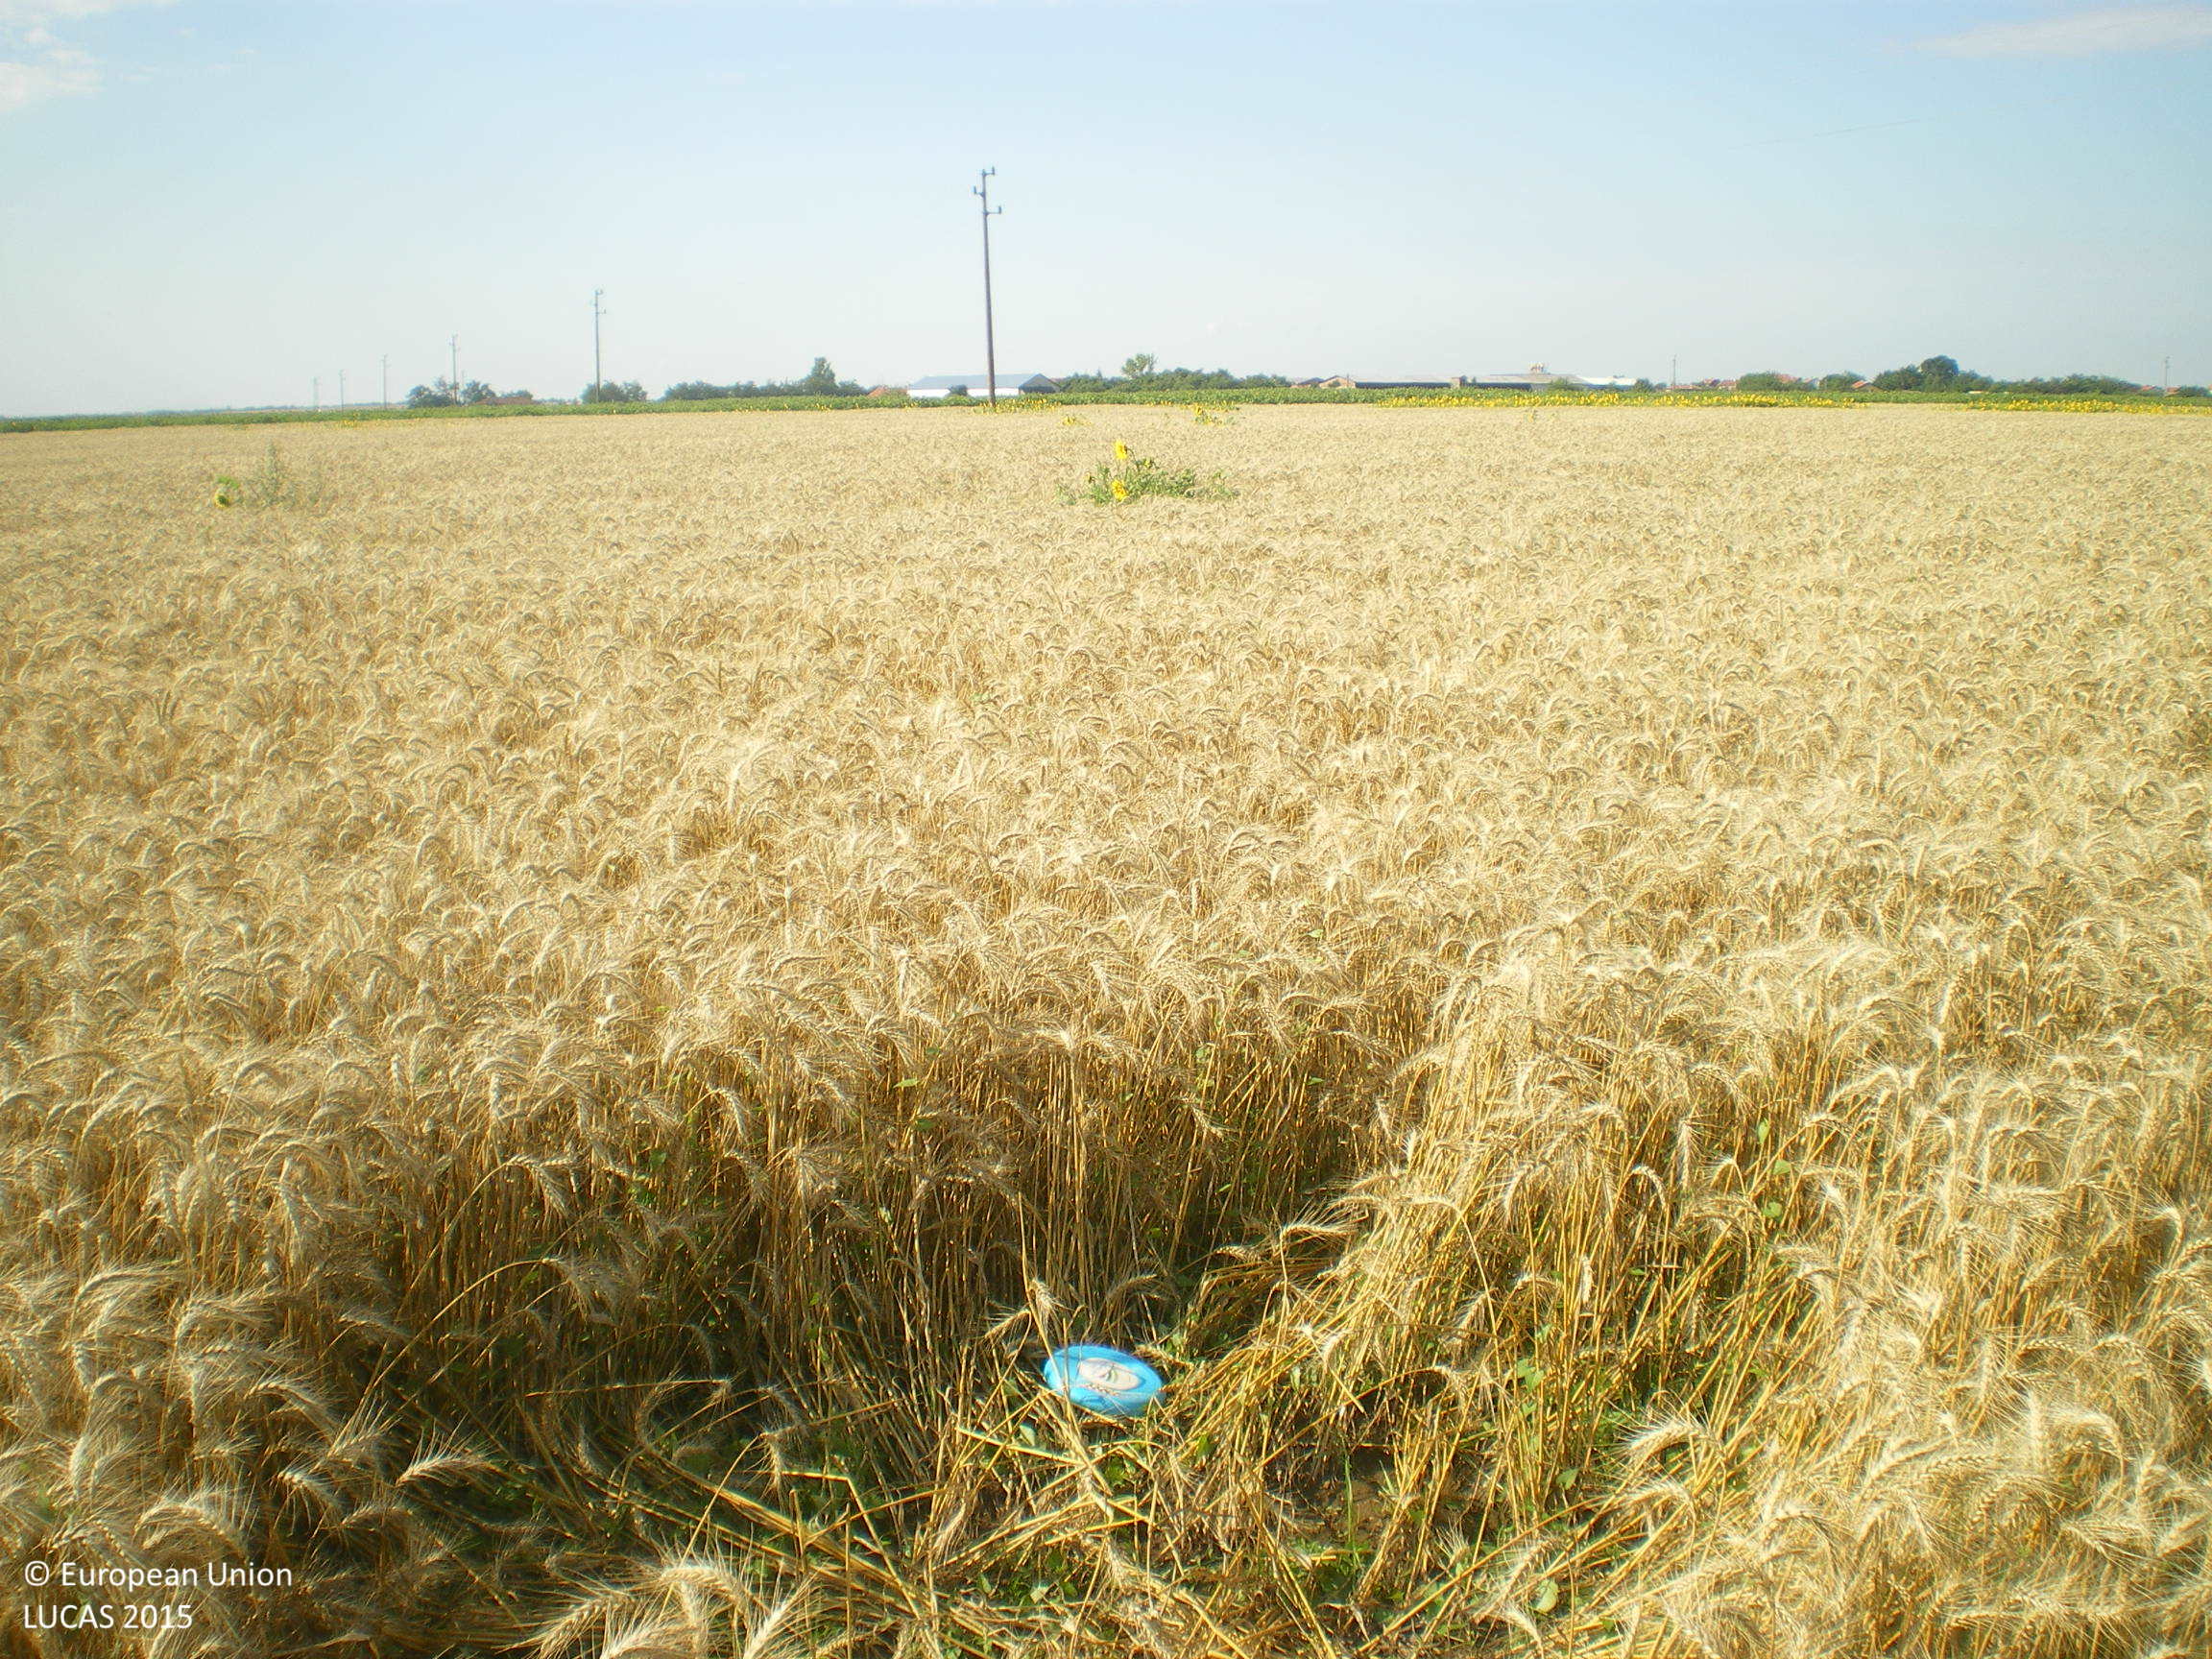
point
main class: Cropland
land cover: Barley
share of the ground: > 75 %
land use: Agriculture (excluding fallow land and kitchen gardens)
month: July
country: BG
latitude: 42.3702
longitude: 25.8502
